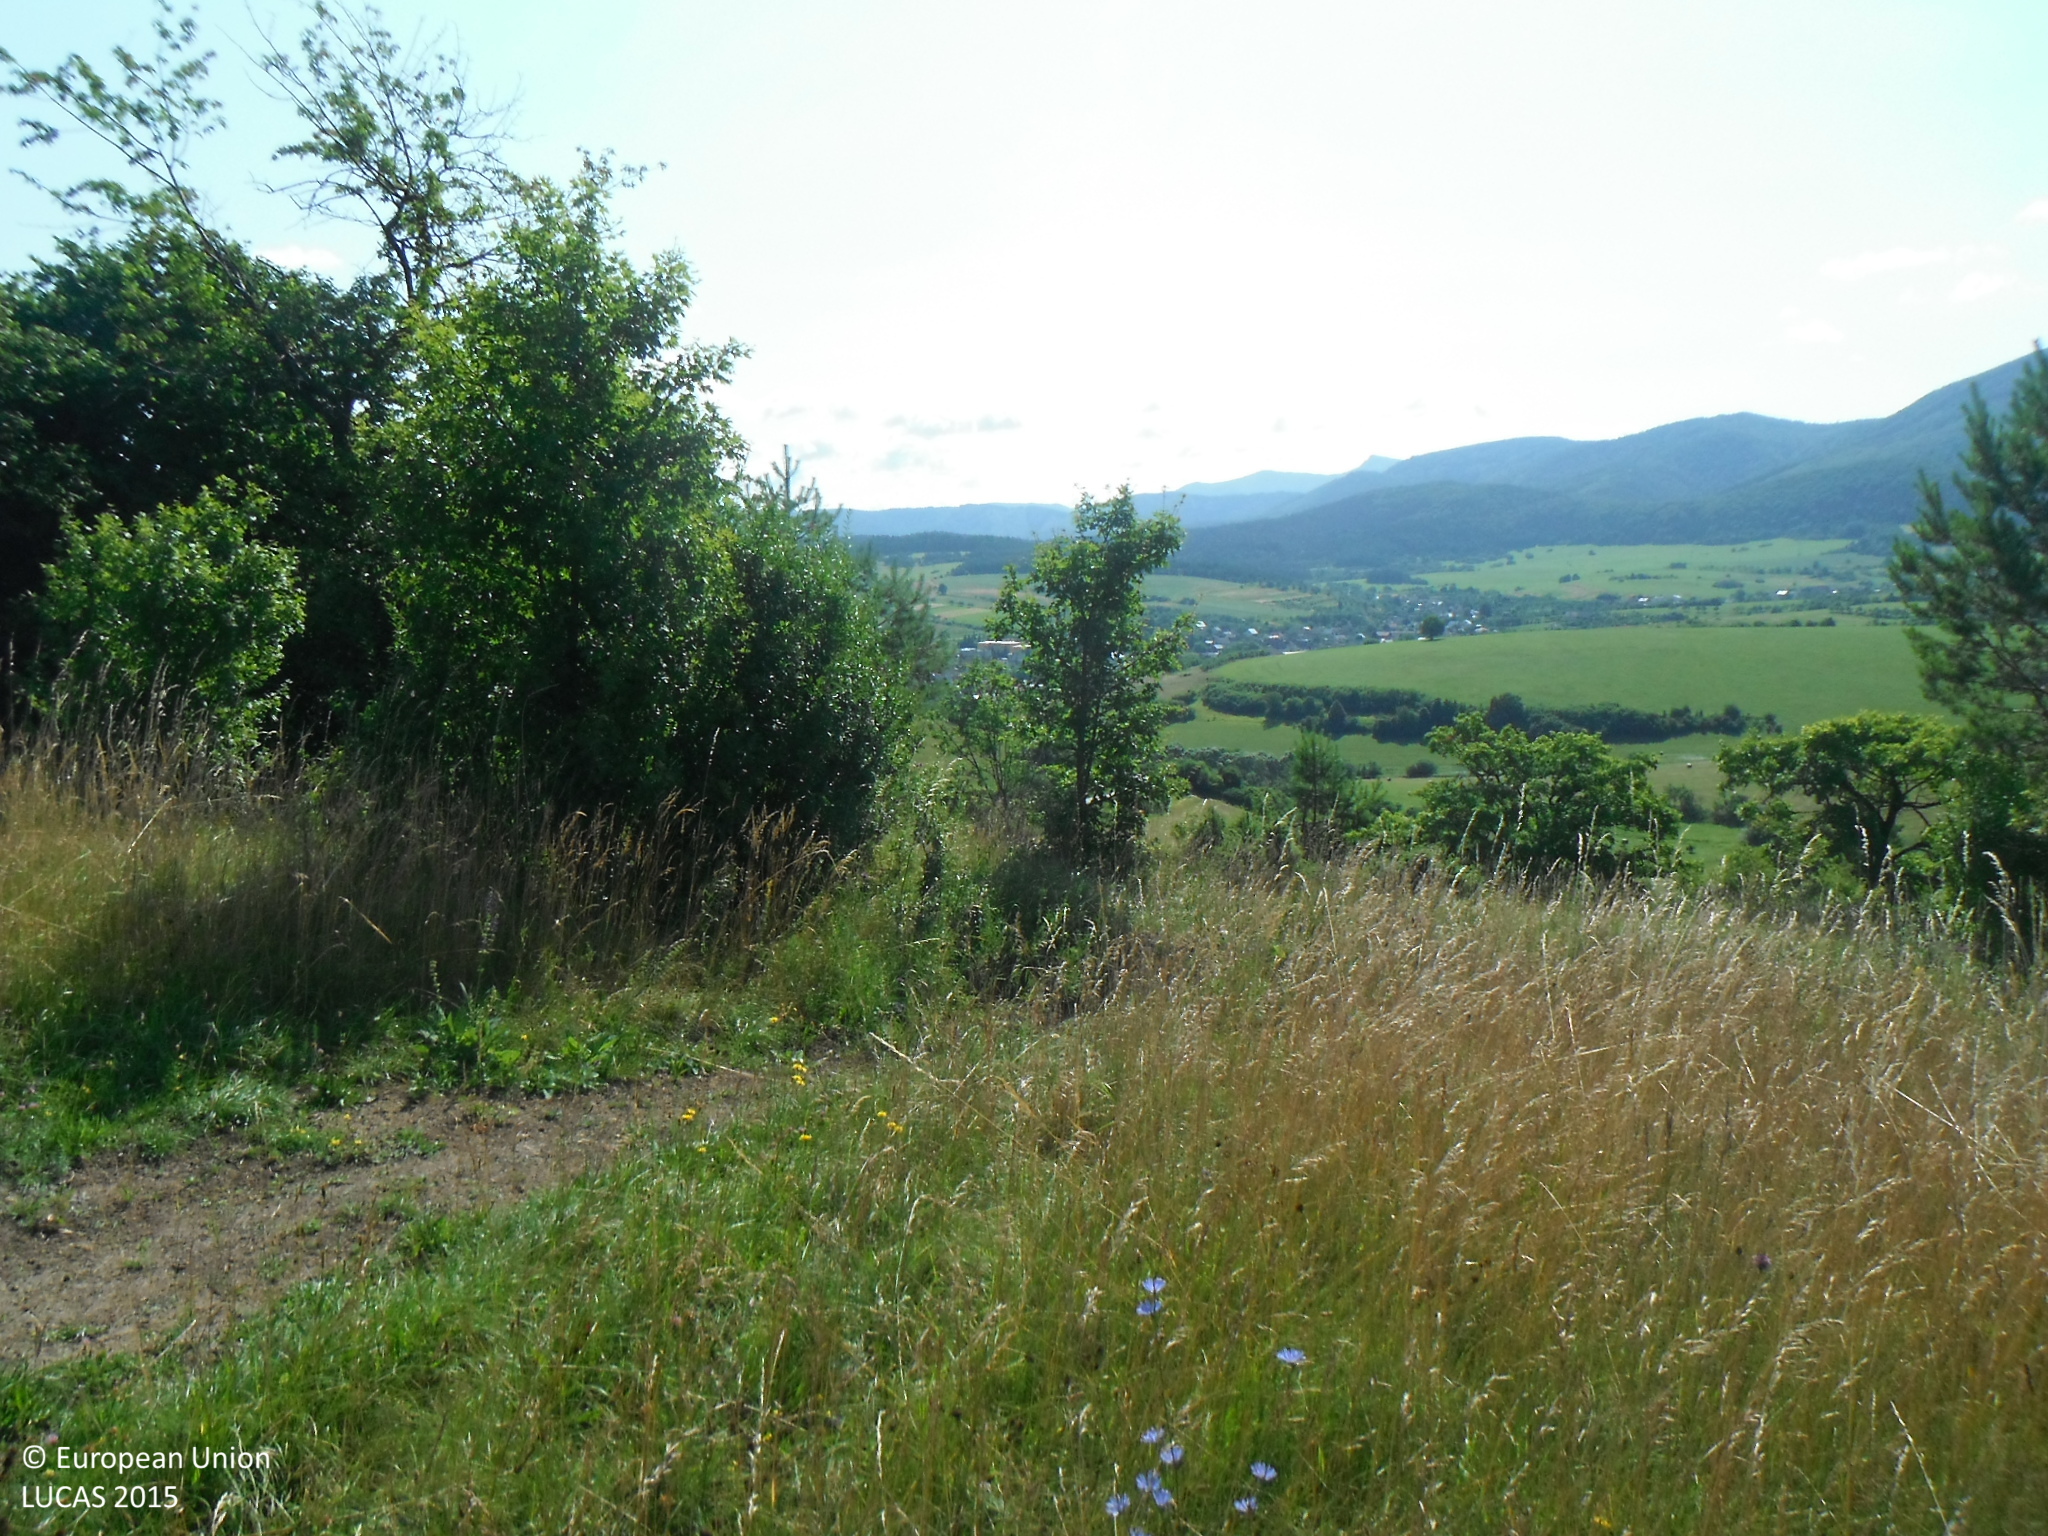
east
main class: Grassland
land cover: Grassland without tree/shrub cover
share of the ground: > 75 %
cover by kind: herbaceous plants 100 %
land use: Agriculture (excluding fallow land and kitchen gardens)
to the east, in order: Grassland without tree/shrub cover; Shrubland with sparse tree cover; Broadleaved woodland; Grassland without tree/shrub cover; Shrubland without tree cover; Shrubland with sparse tree cover; Paved roads, cycling and walking lanes
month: July
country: SK
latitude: 49.0199
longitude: 18.4545
